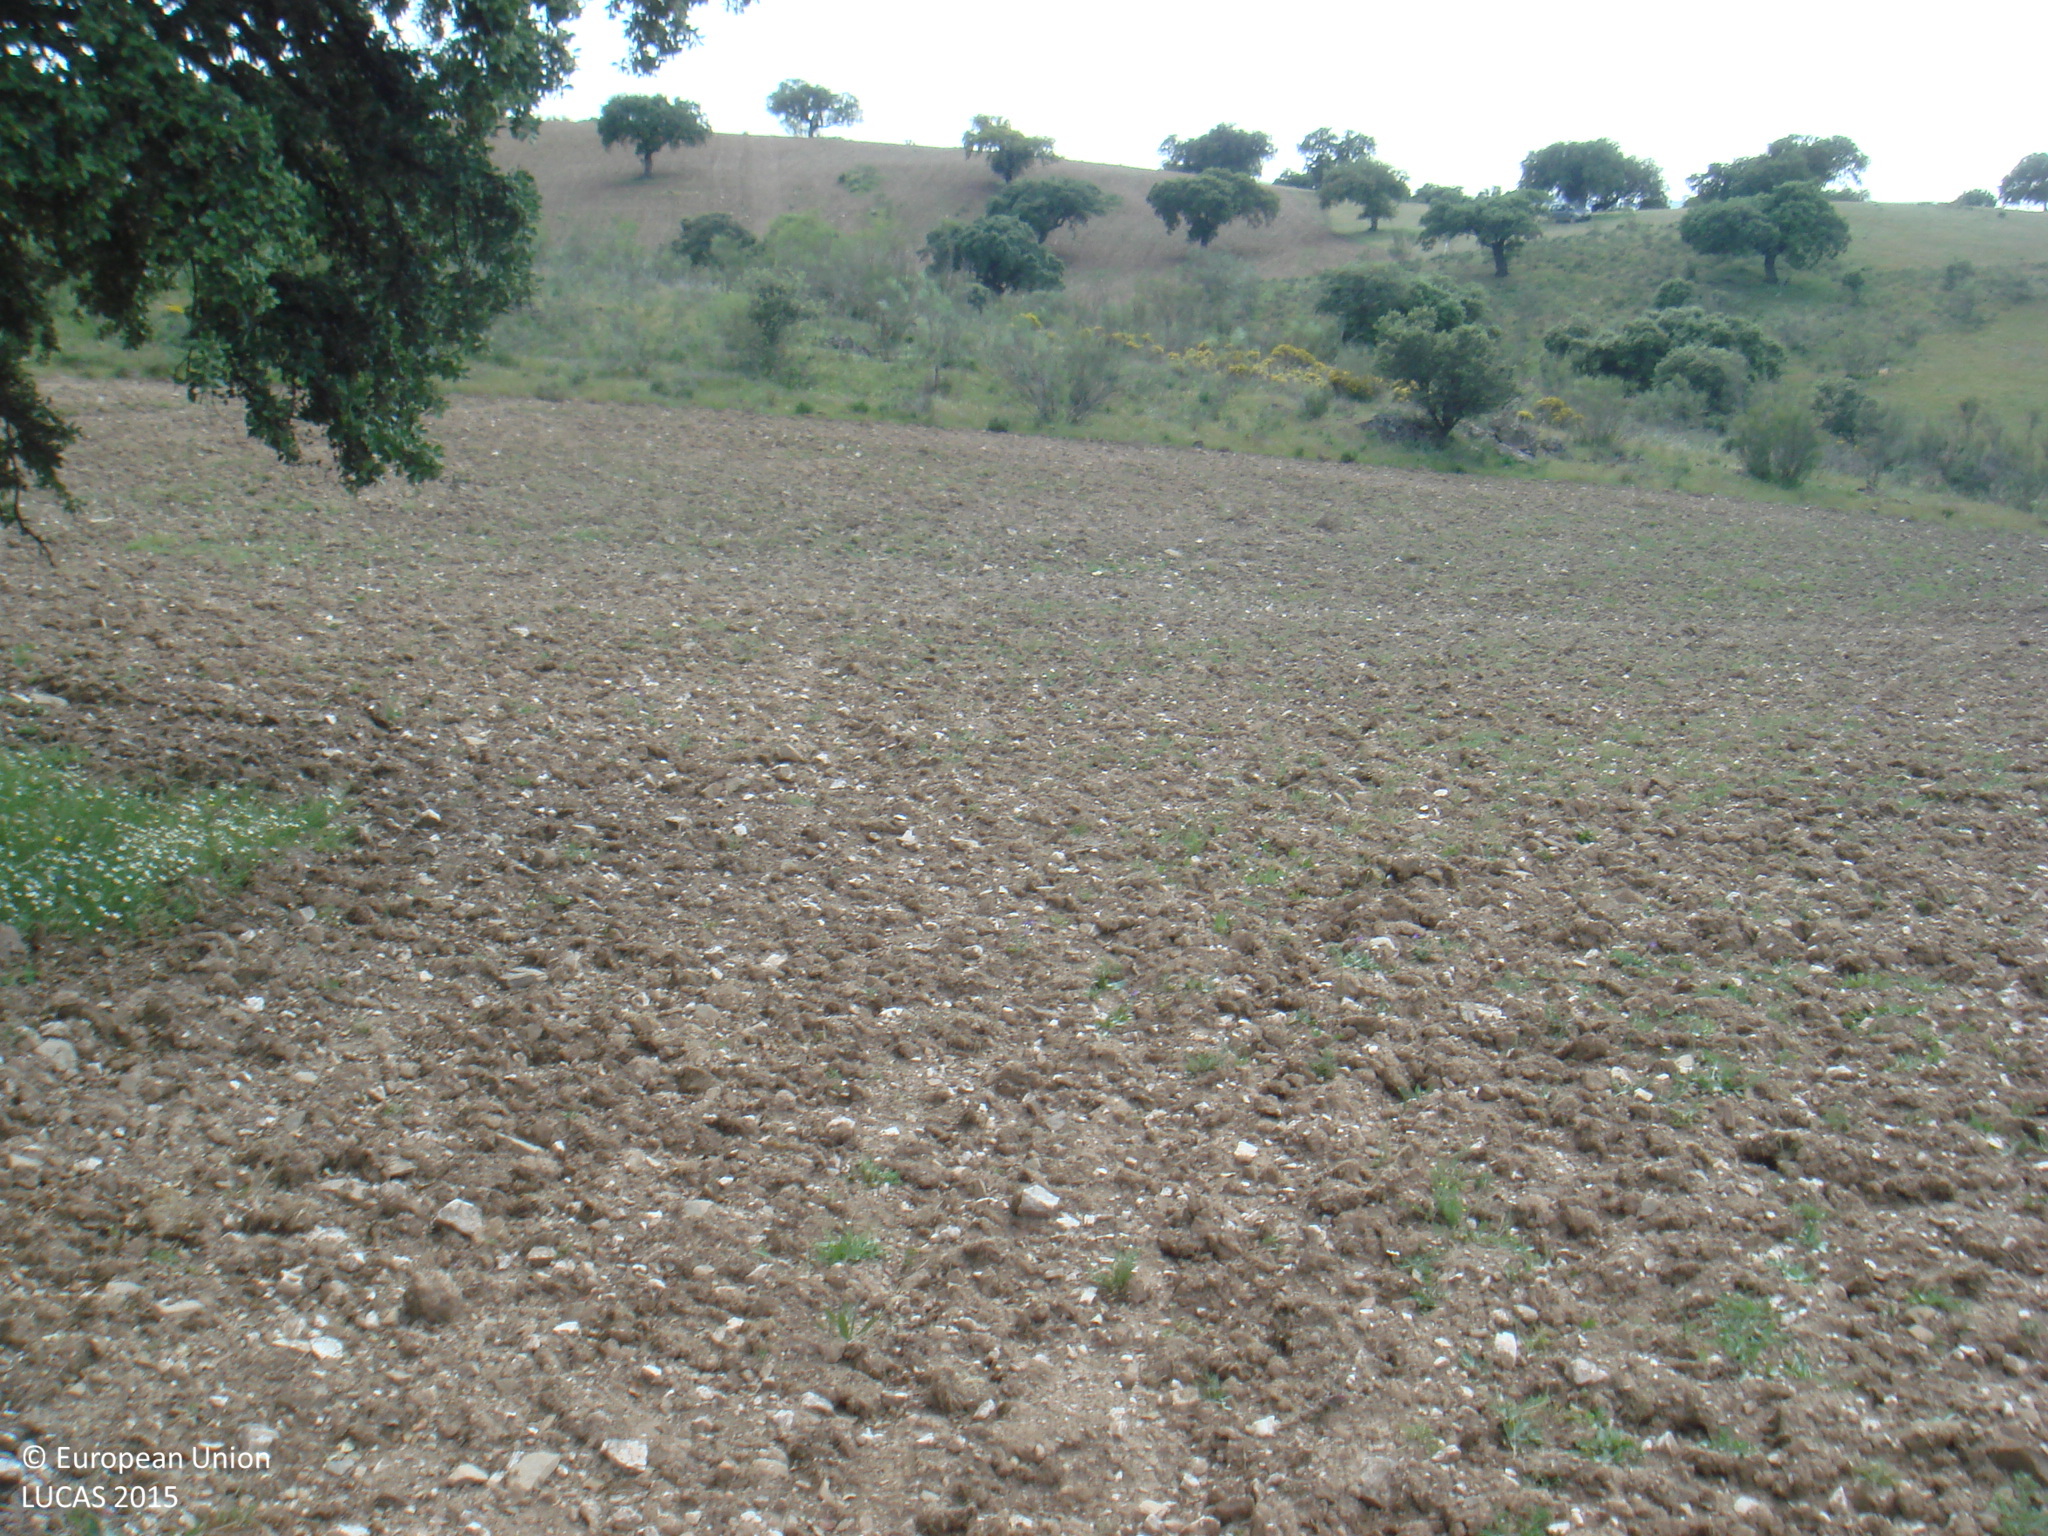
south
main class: Woodland
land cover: Broadleaved woodland
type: broadleaved evergreen forest
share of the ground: 25 - 50 %
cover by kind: unconsolidated bare surface 70 %, broadleaved forest trees 30 %
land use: Forestry
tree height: > 5 m
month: May
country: ES
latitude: 38.3846
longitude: -5.0347
